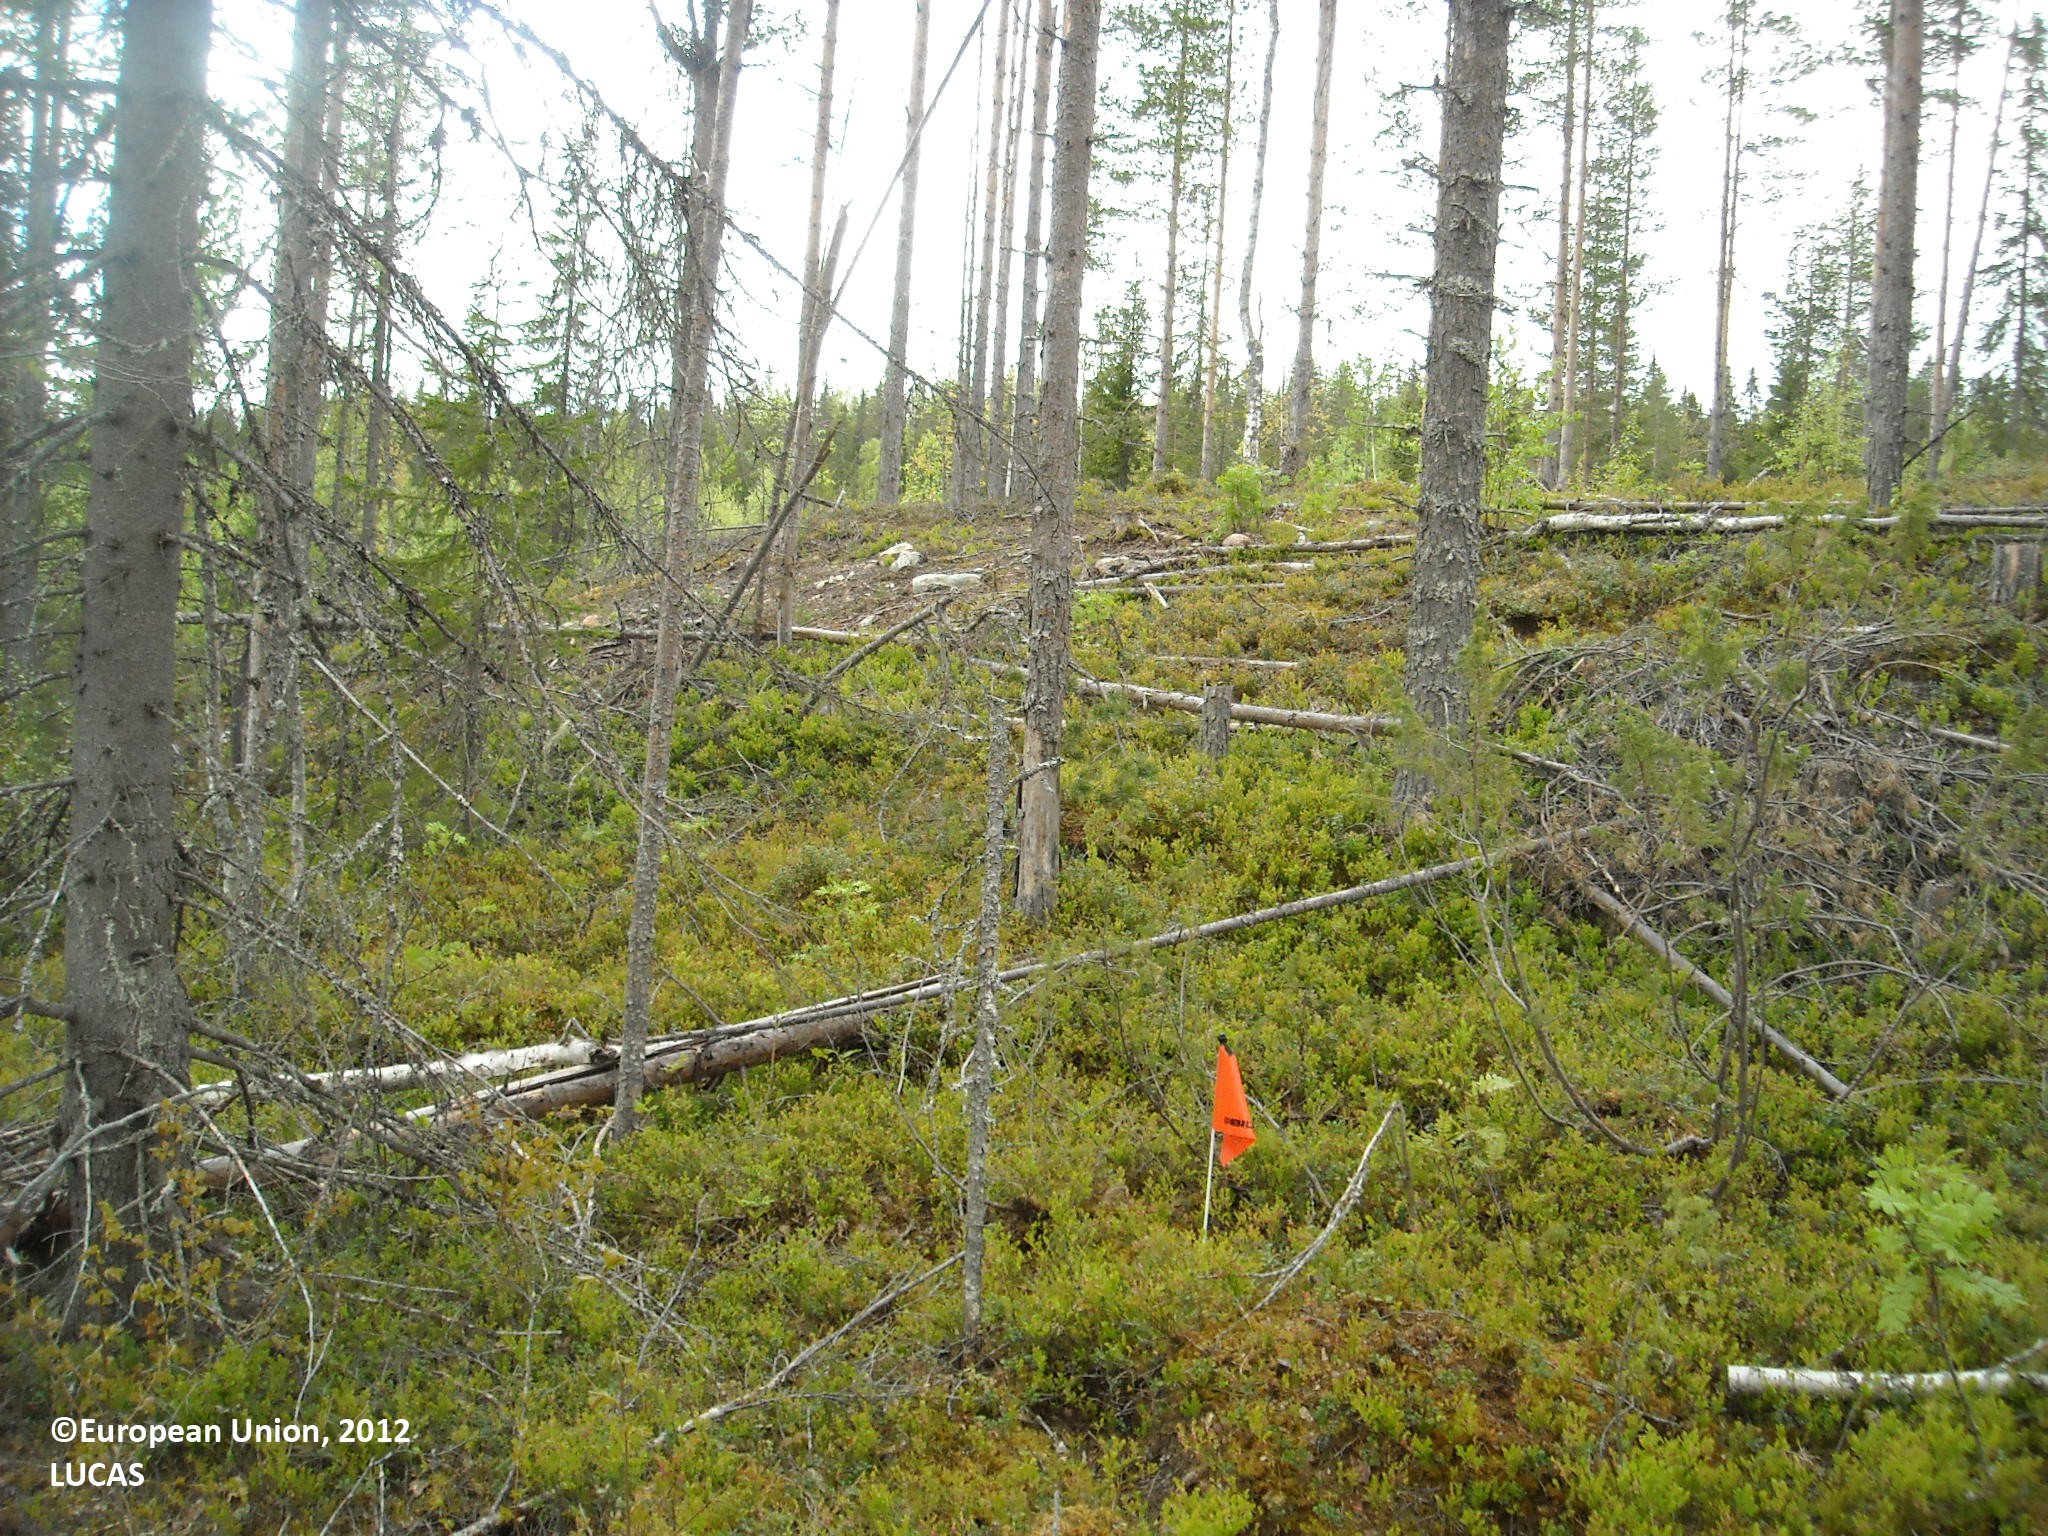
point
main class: Woodland
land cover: Pine dominated coniferous woodland
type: boreal forest
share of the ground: 50 - 75 %
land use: Forestry
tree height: > 5 m
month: June
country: FI
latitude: 65.1456
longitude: 27.9970
